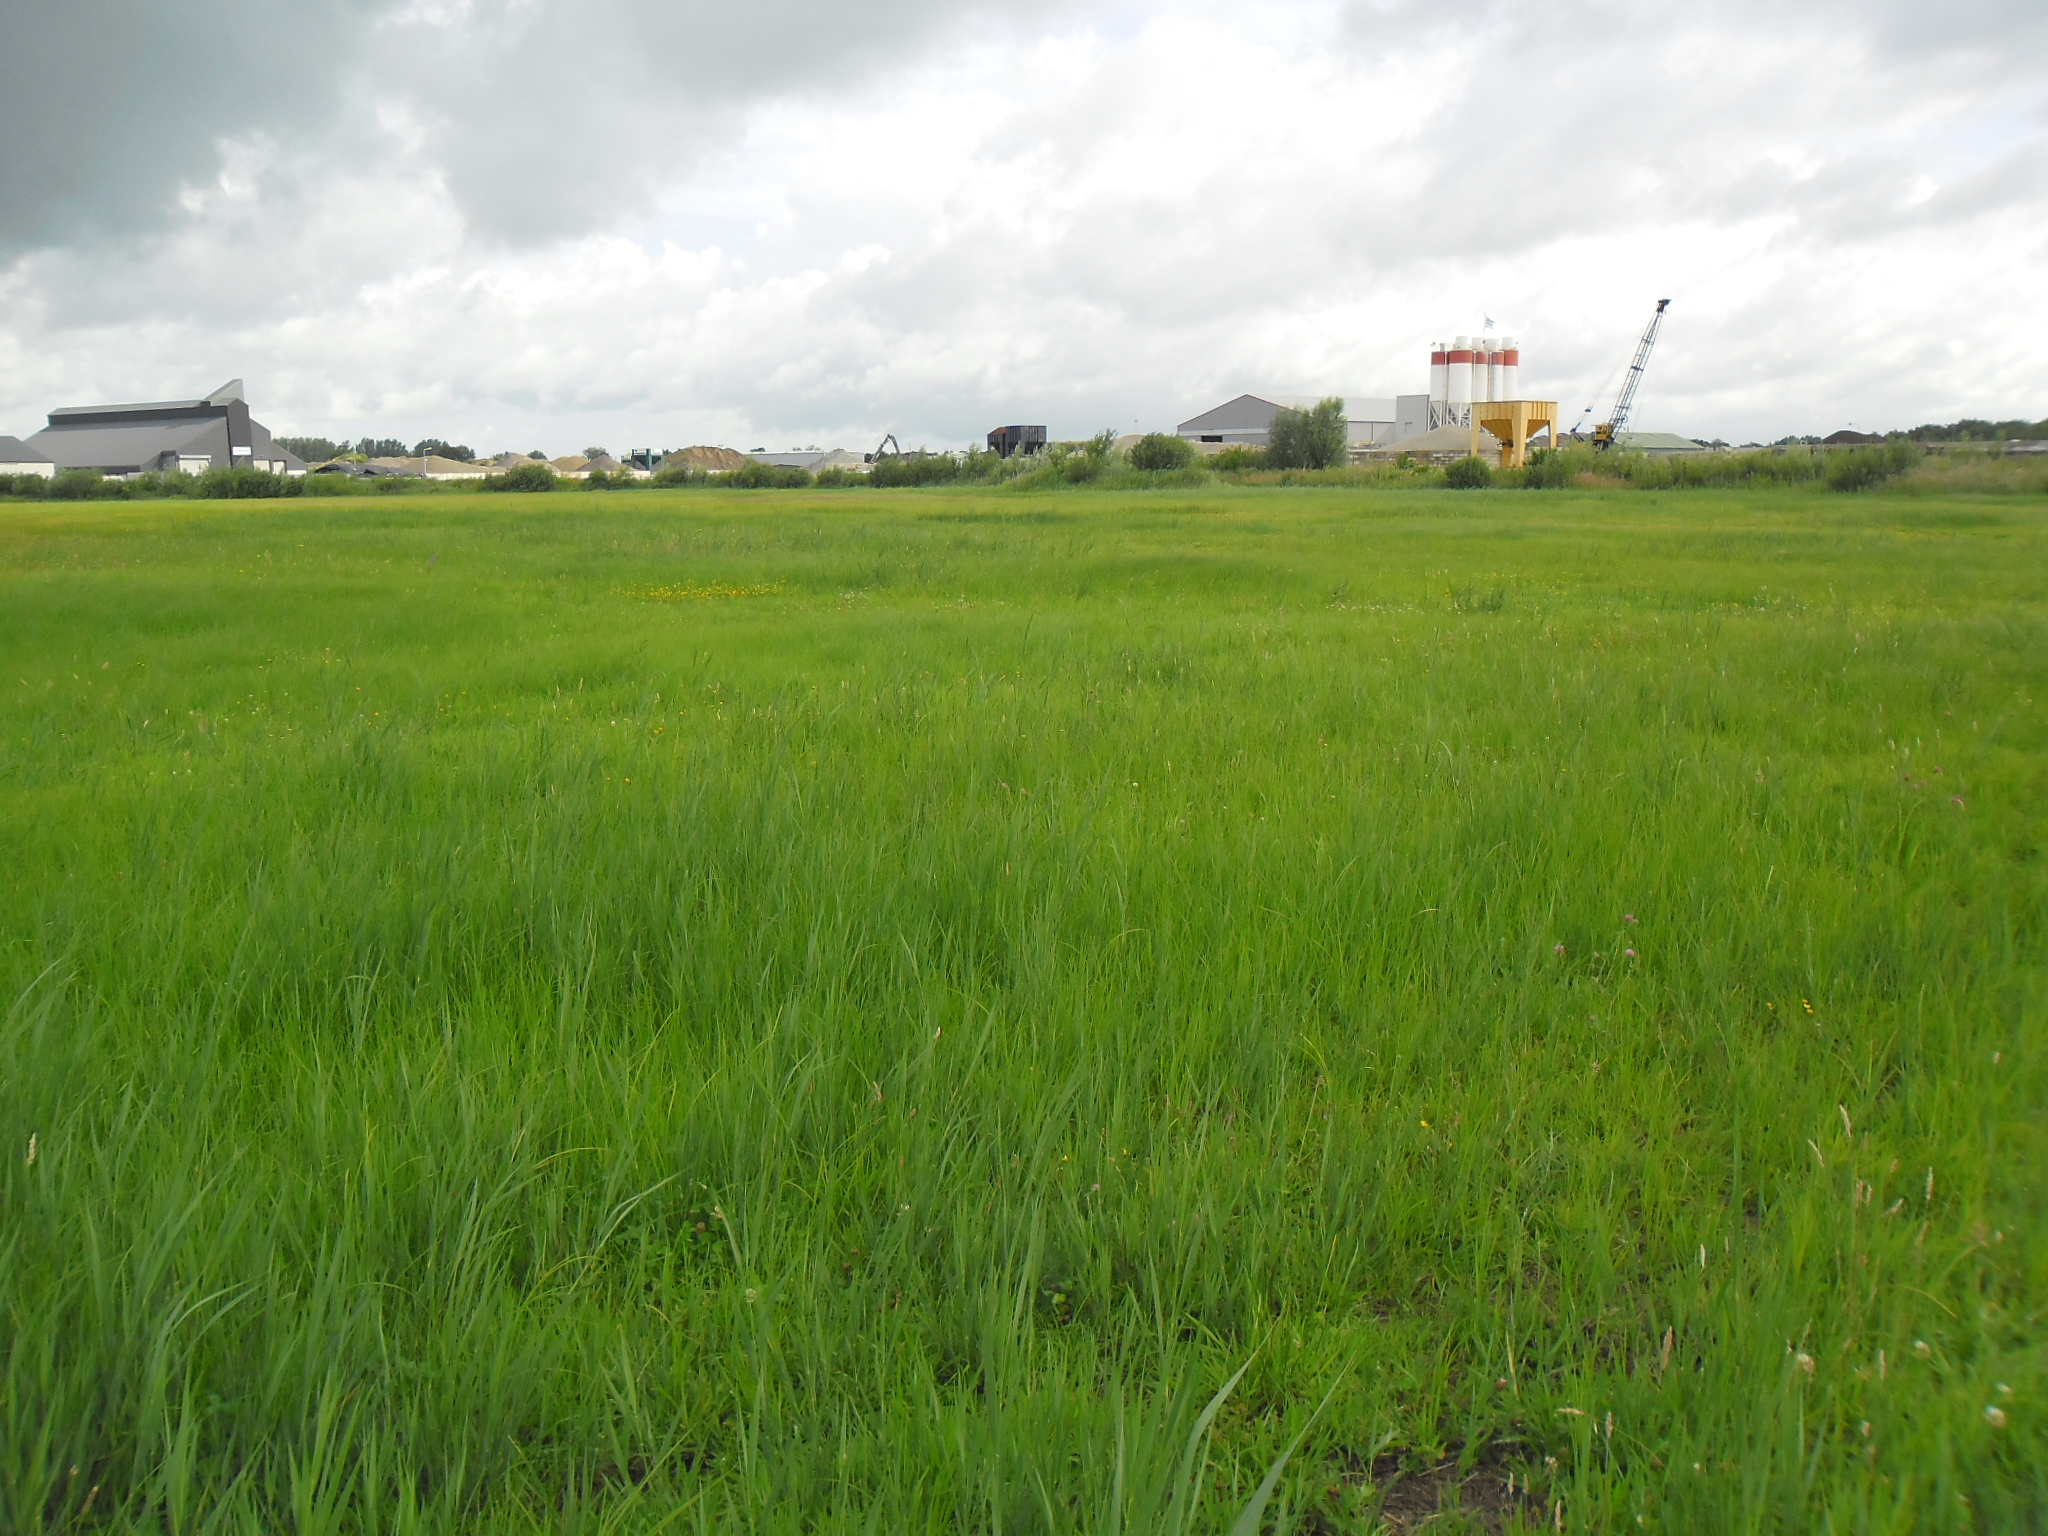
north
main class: Grassland
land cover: Grassland without tree/shrub cover
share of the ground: > 75 %
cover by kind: herbaceous plants 100 %
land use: Logistics and storage
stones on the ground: < 10 %
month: July
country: NL
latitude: 52.6936
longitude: 6.1674
